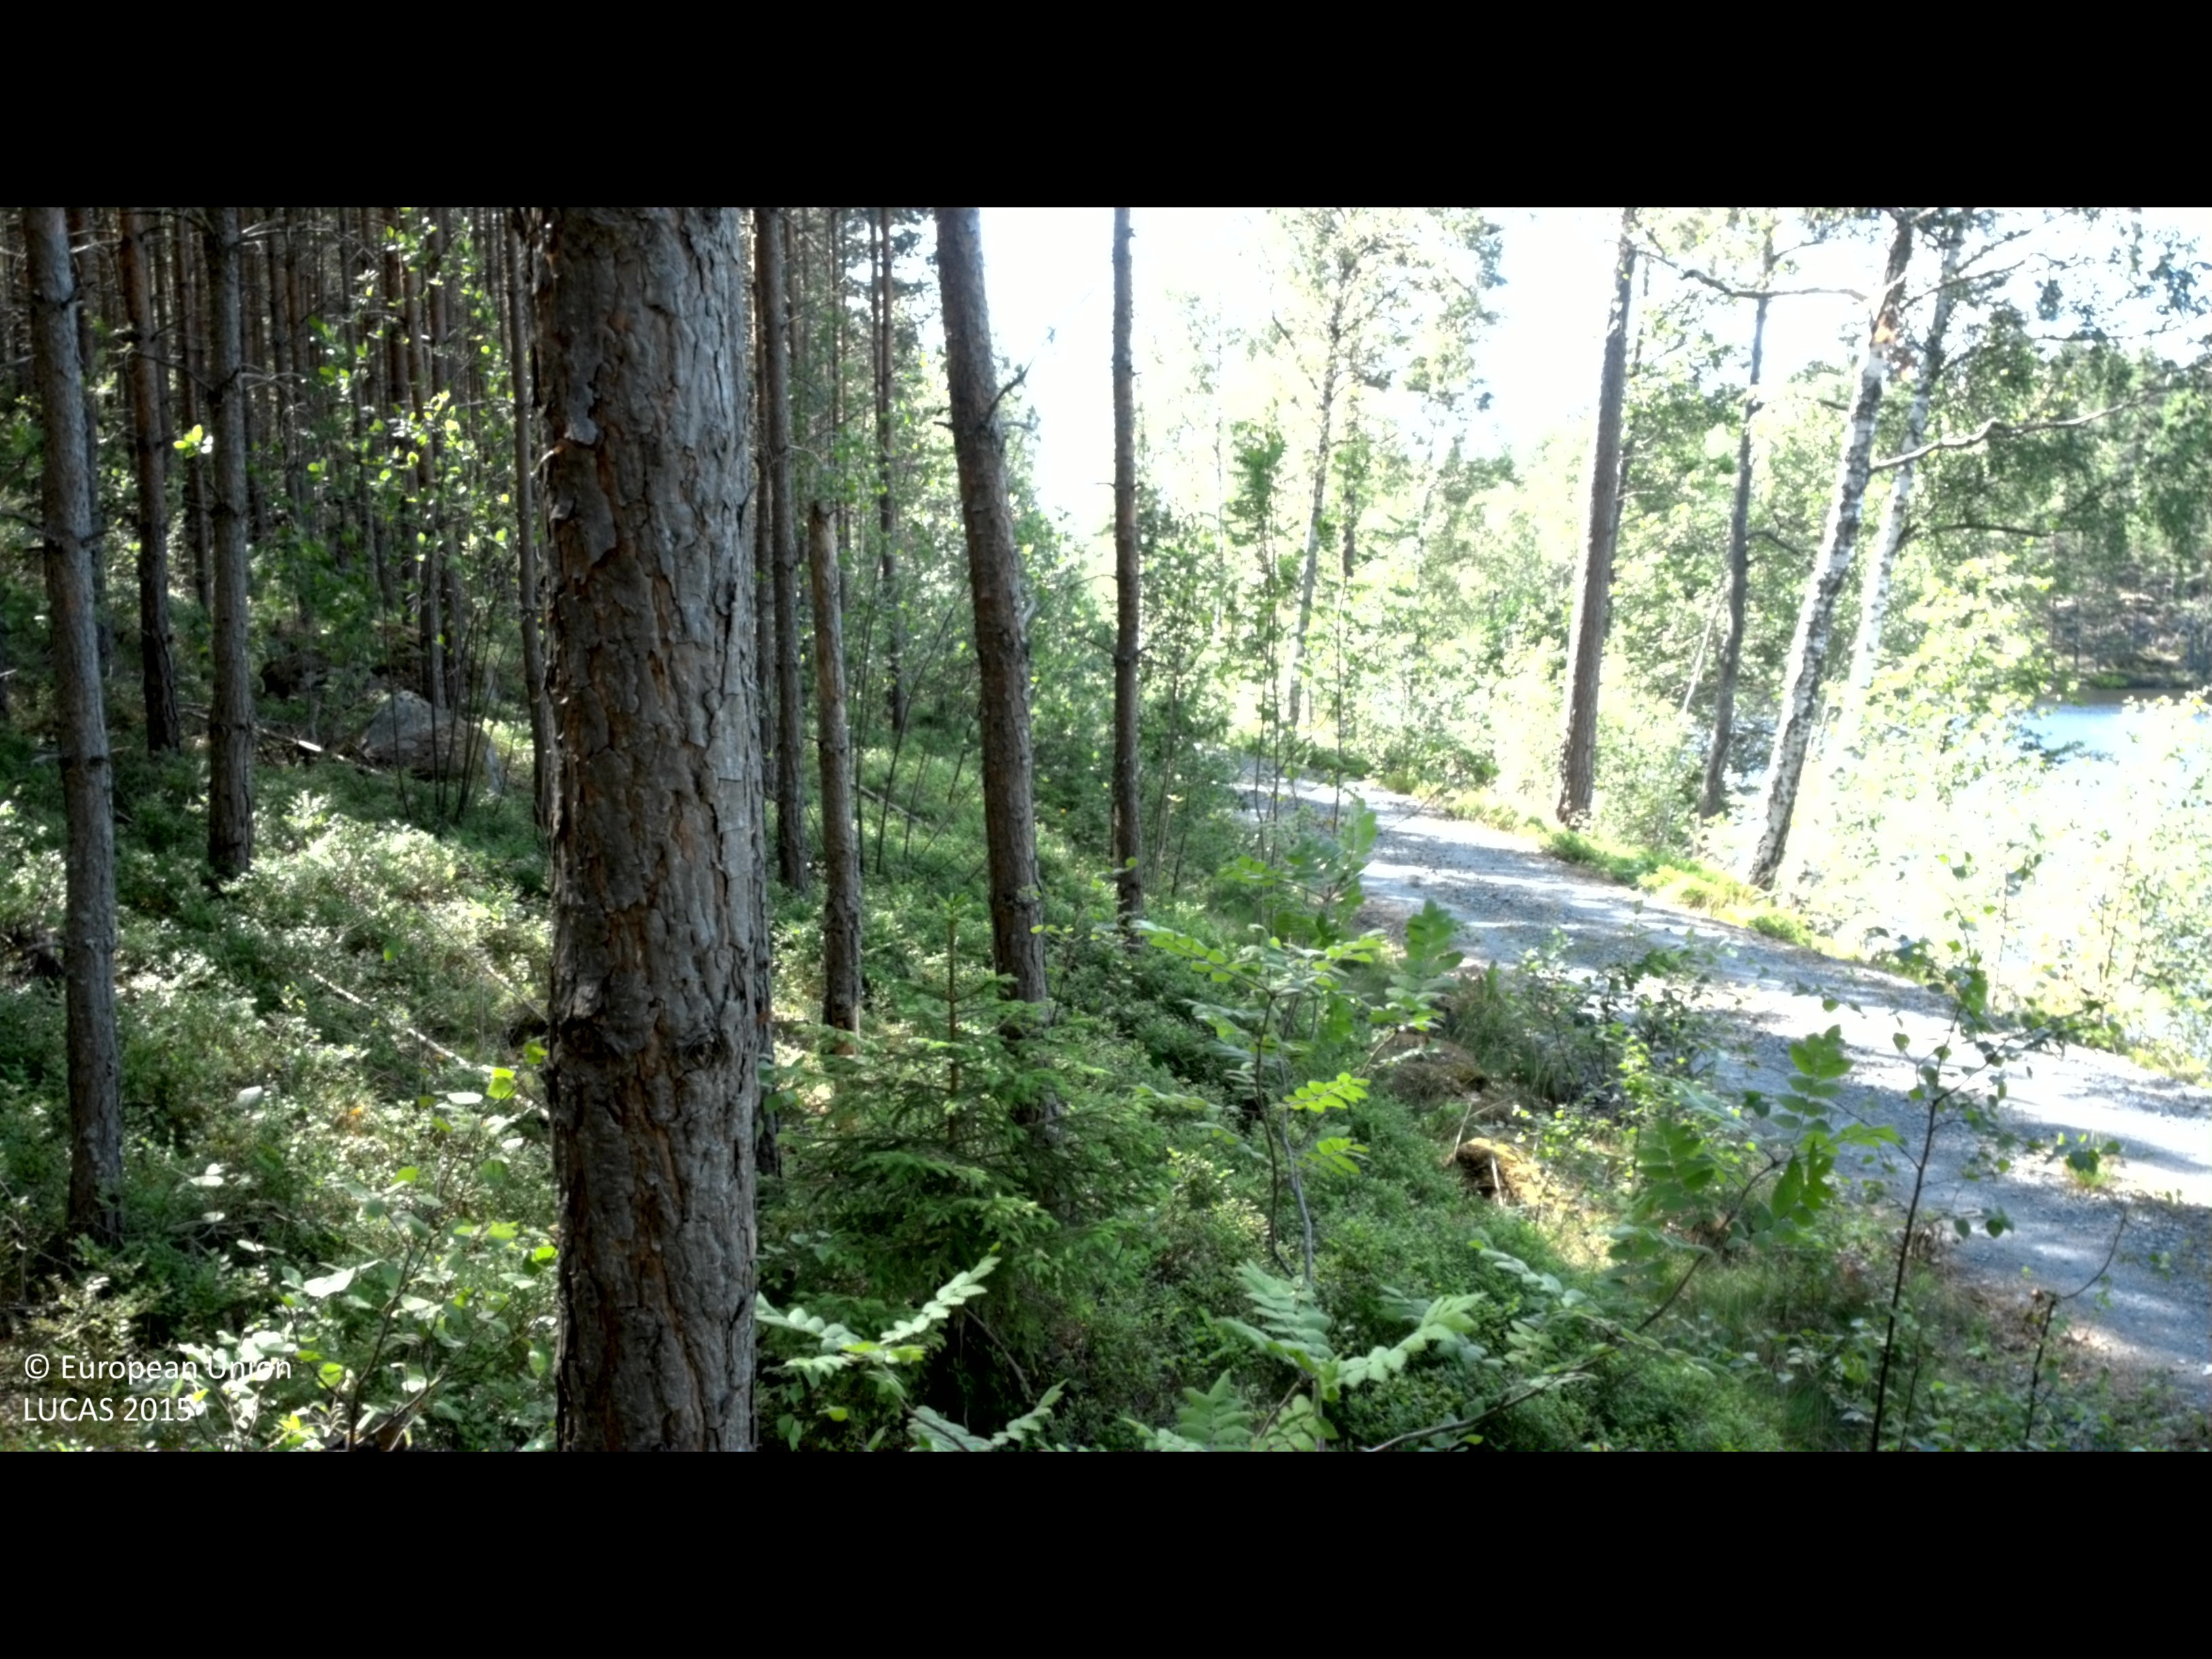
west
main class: Woodland
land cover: Pine dominated coniferous woodland
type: boreal forest
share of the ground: > 75 %
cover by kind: coniferous forest trees 70 %, shrubs 20 %, broadleaved forest trees 10 %
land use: Forestry
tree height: > 5 m
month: July
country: SE
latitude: 58.3215
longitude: 16.3644
